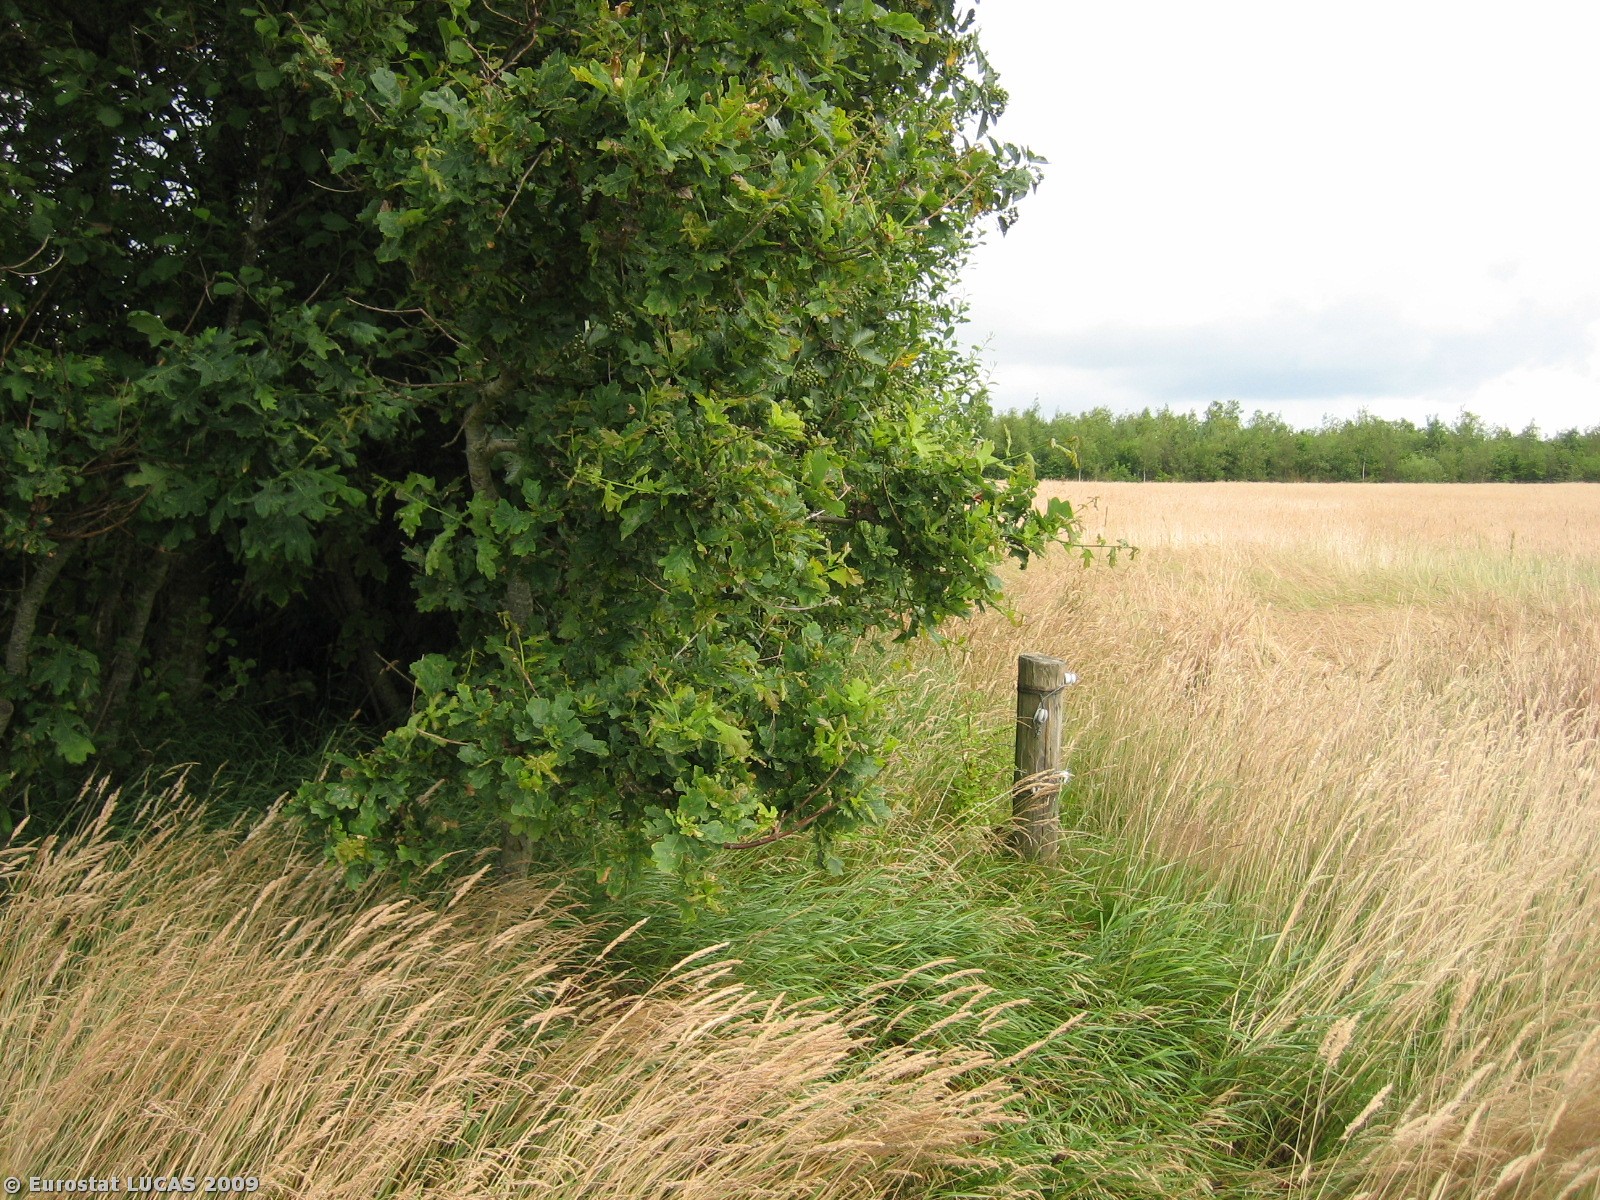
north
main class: Grassland
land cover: Grassland without tree/shrub cover
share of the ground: > 75 %
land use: Agriculture (excluding fallow land and kitchen gardens)
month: July
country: DK
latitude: 55.5680
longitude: 8.5265
